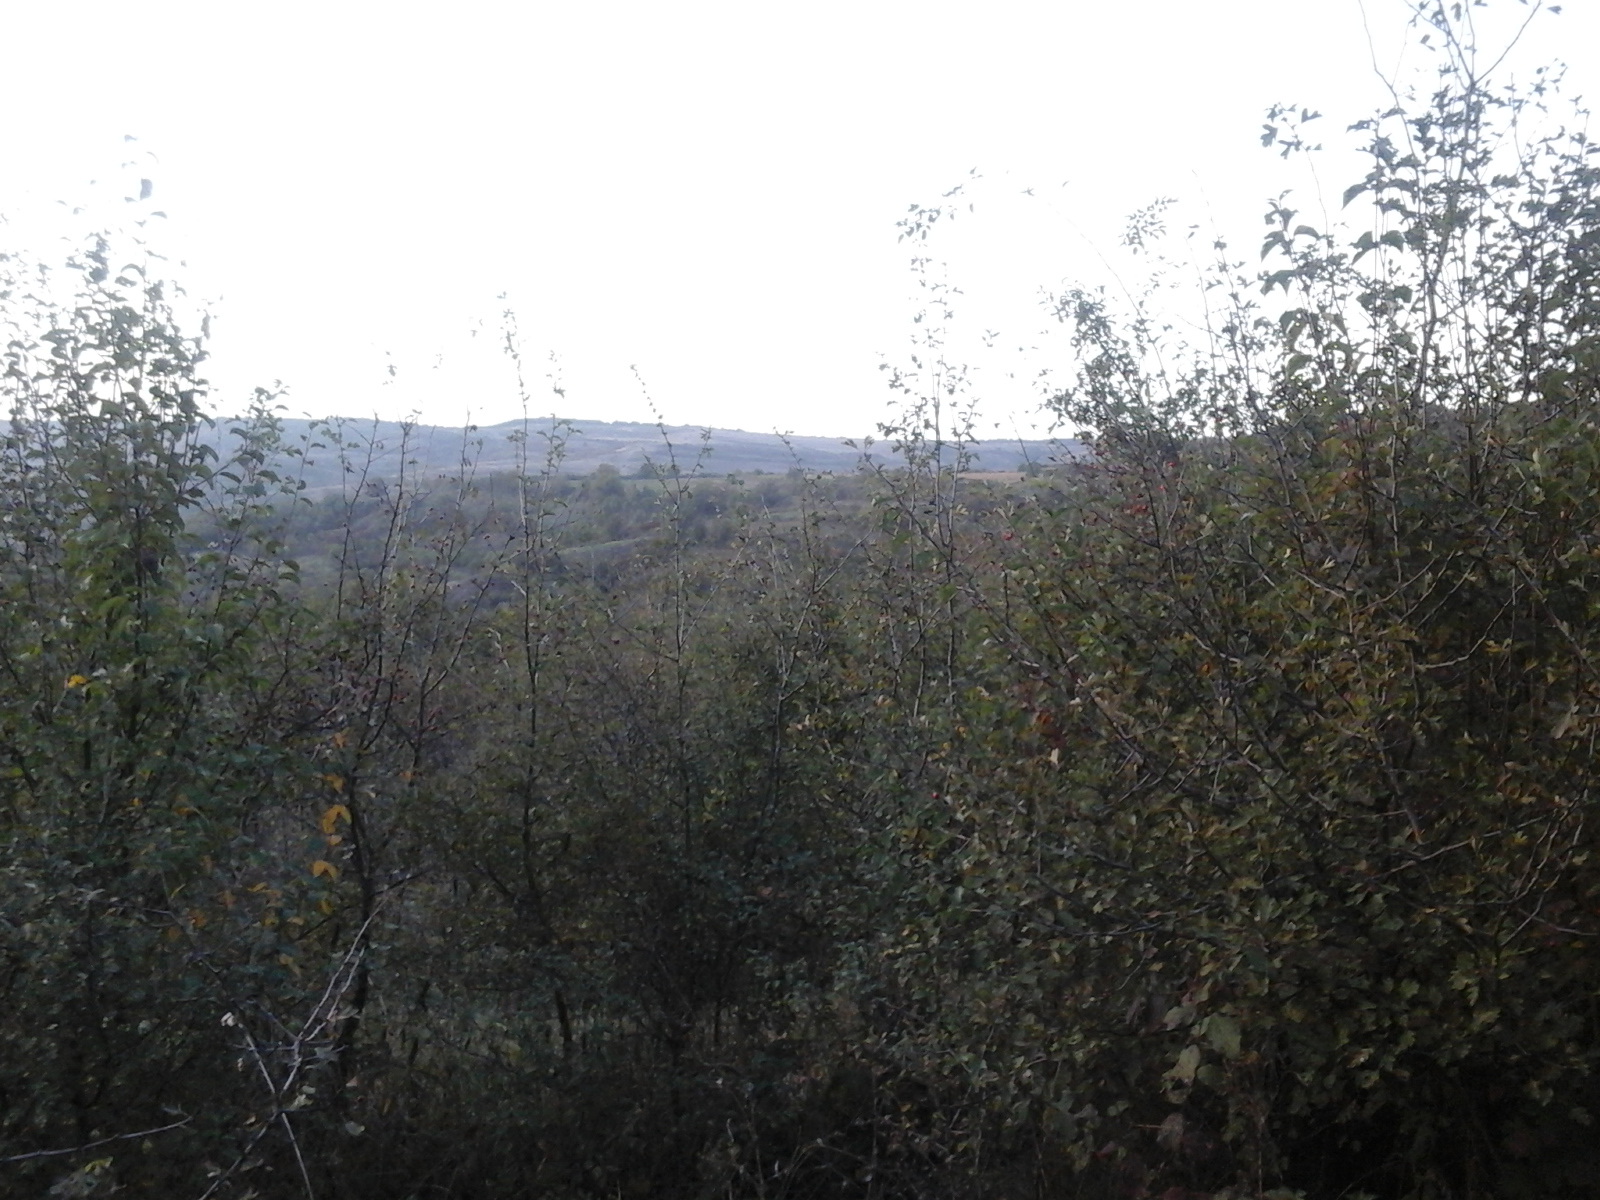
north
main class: Shrubland
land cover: Shrubland without tree cover
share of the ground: > 75 %
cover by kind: shrubs 100 %
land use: Semi-natural and natural areas not in use
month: September
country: RO
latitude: 46.9639
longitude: 24.1048
